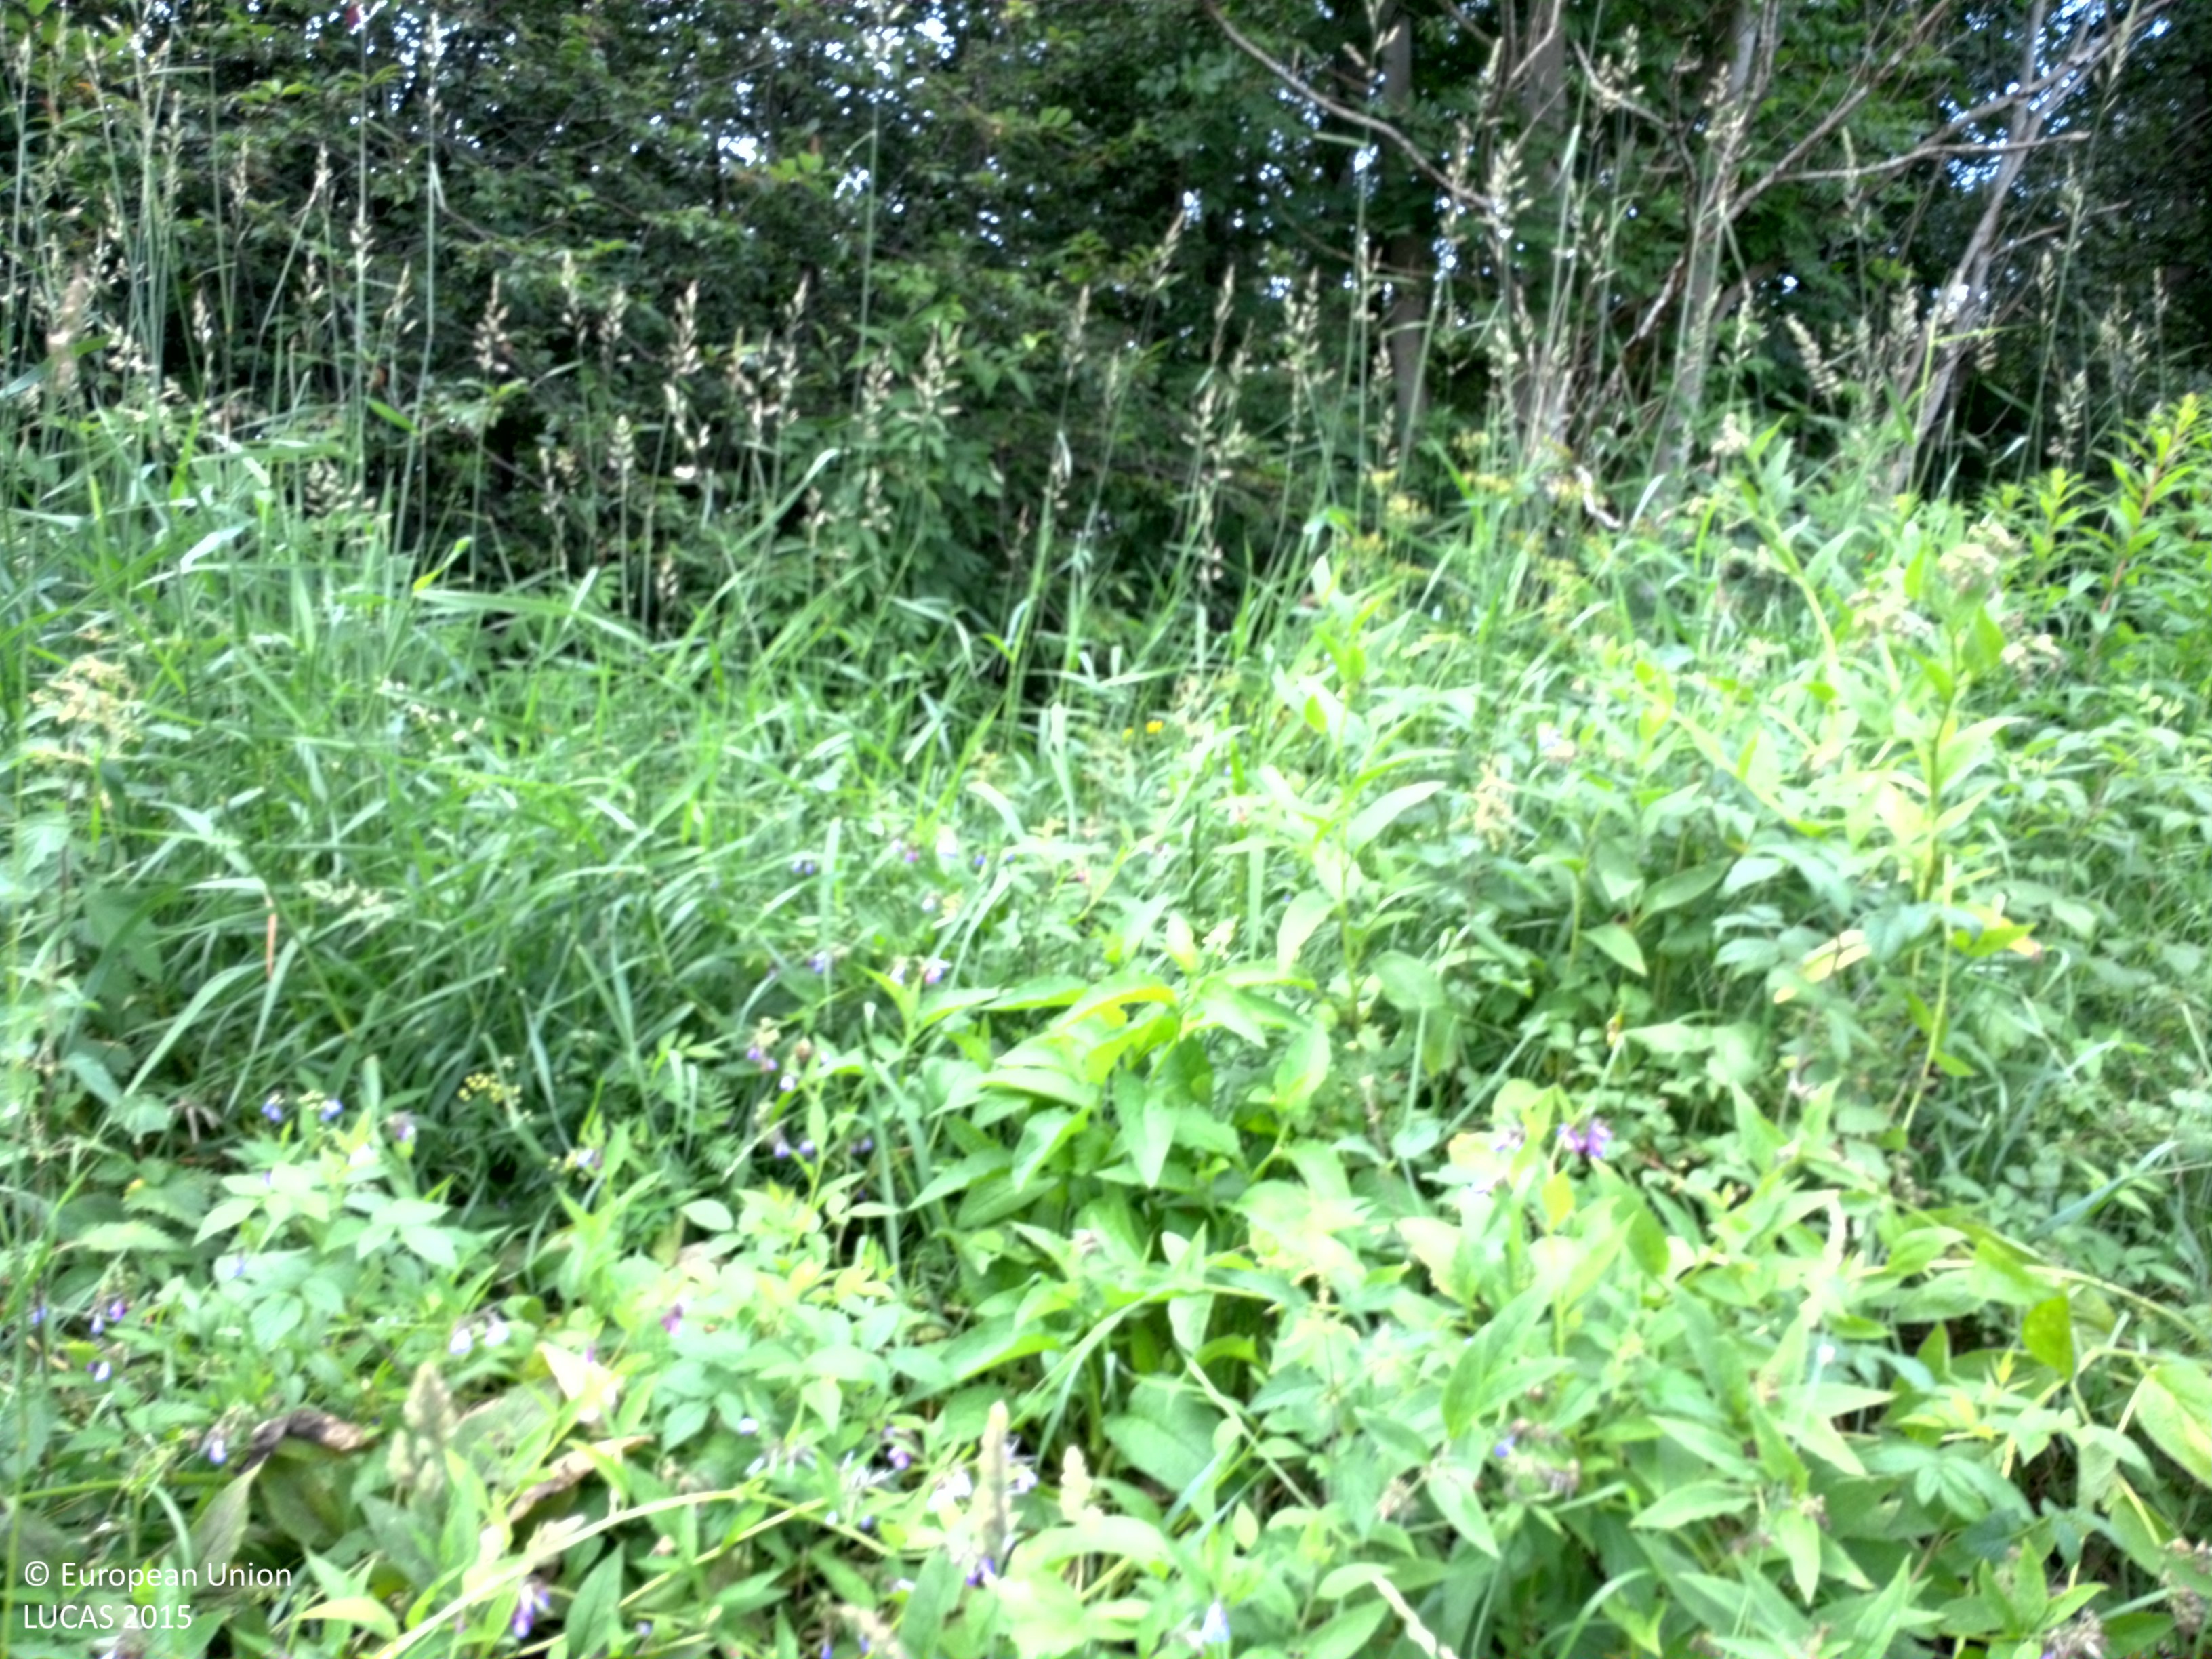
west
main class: Grassland
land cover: Grassland without tree/shrub cover
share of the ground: > 75 %
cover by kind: herbaceous plants 90 %, shrubs 5 %, unconsolidated bare surface 5 %
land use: Semi-natural and natural areas not in use
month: July
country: SE
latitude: 57.5061
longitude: 14.7191
